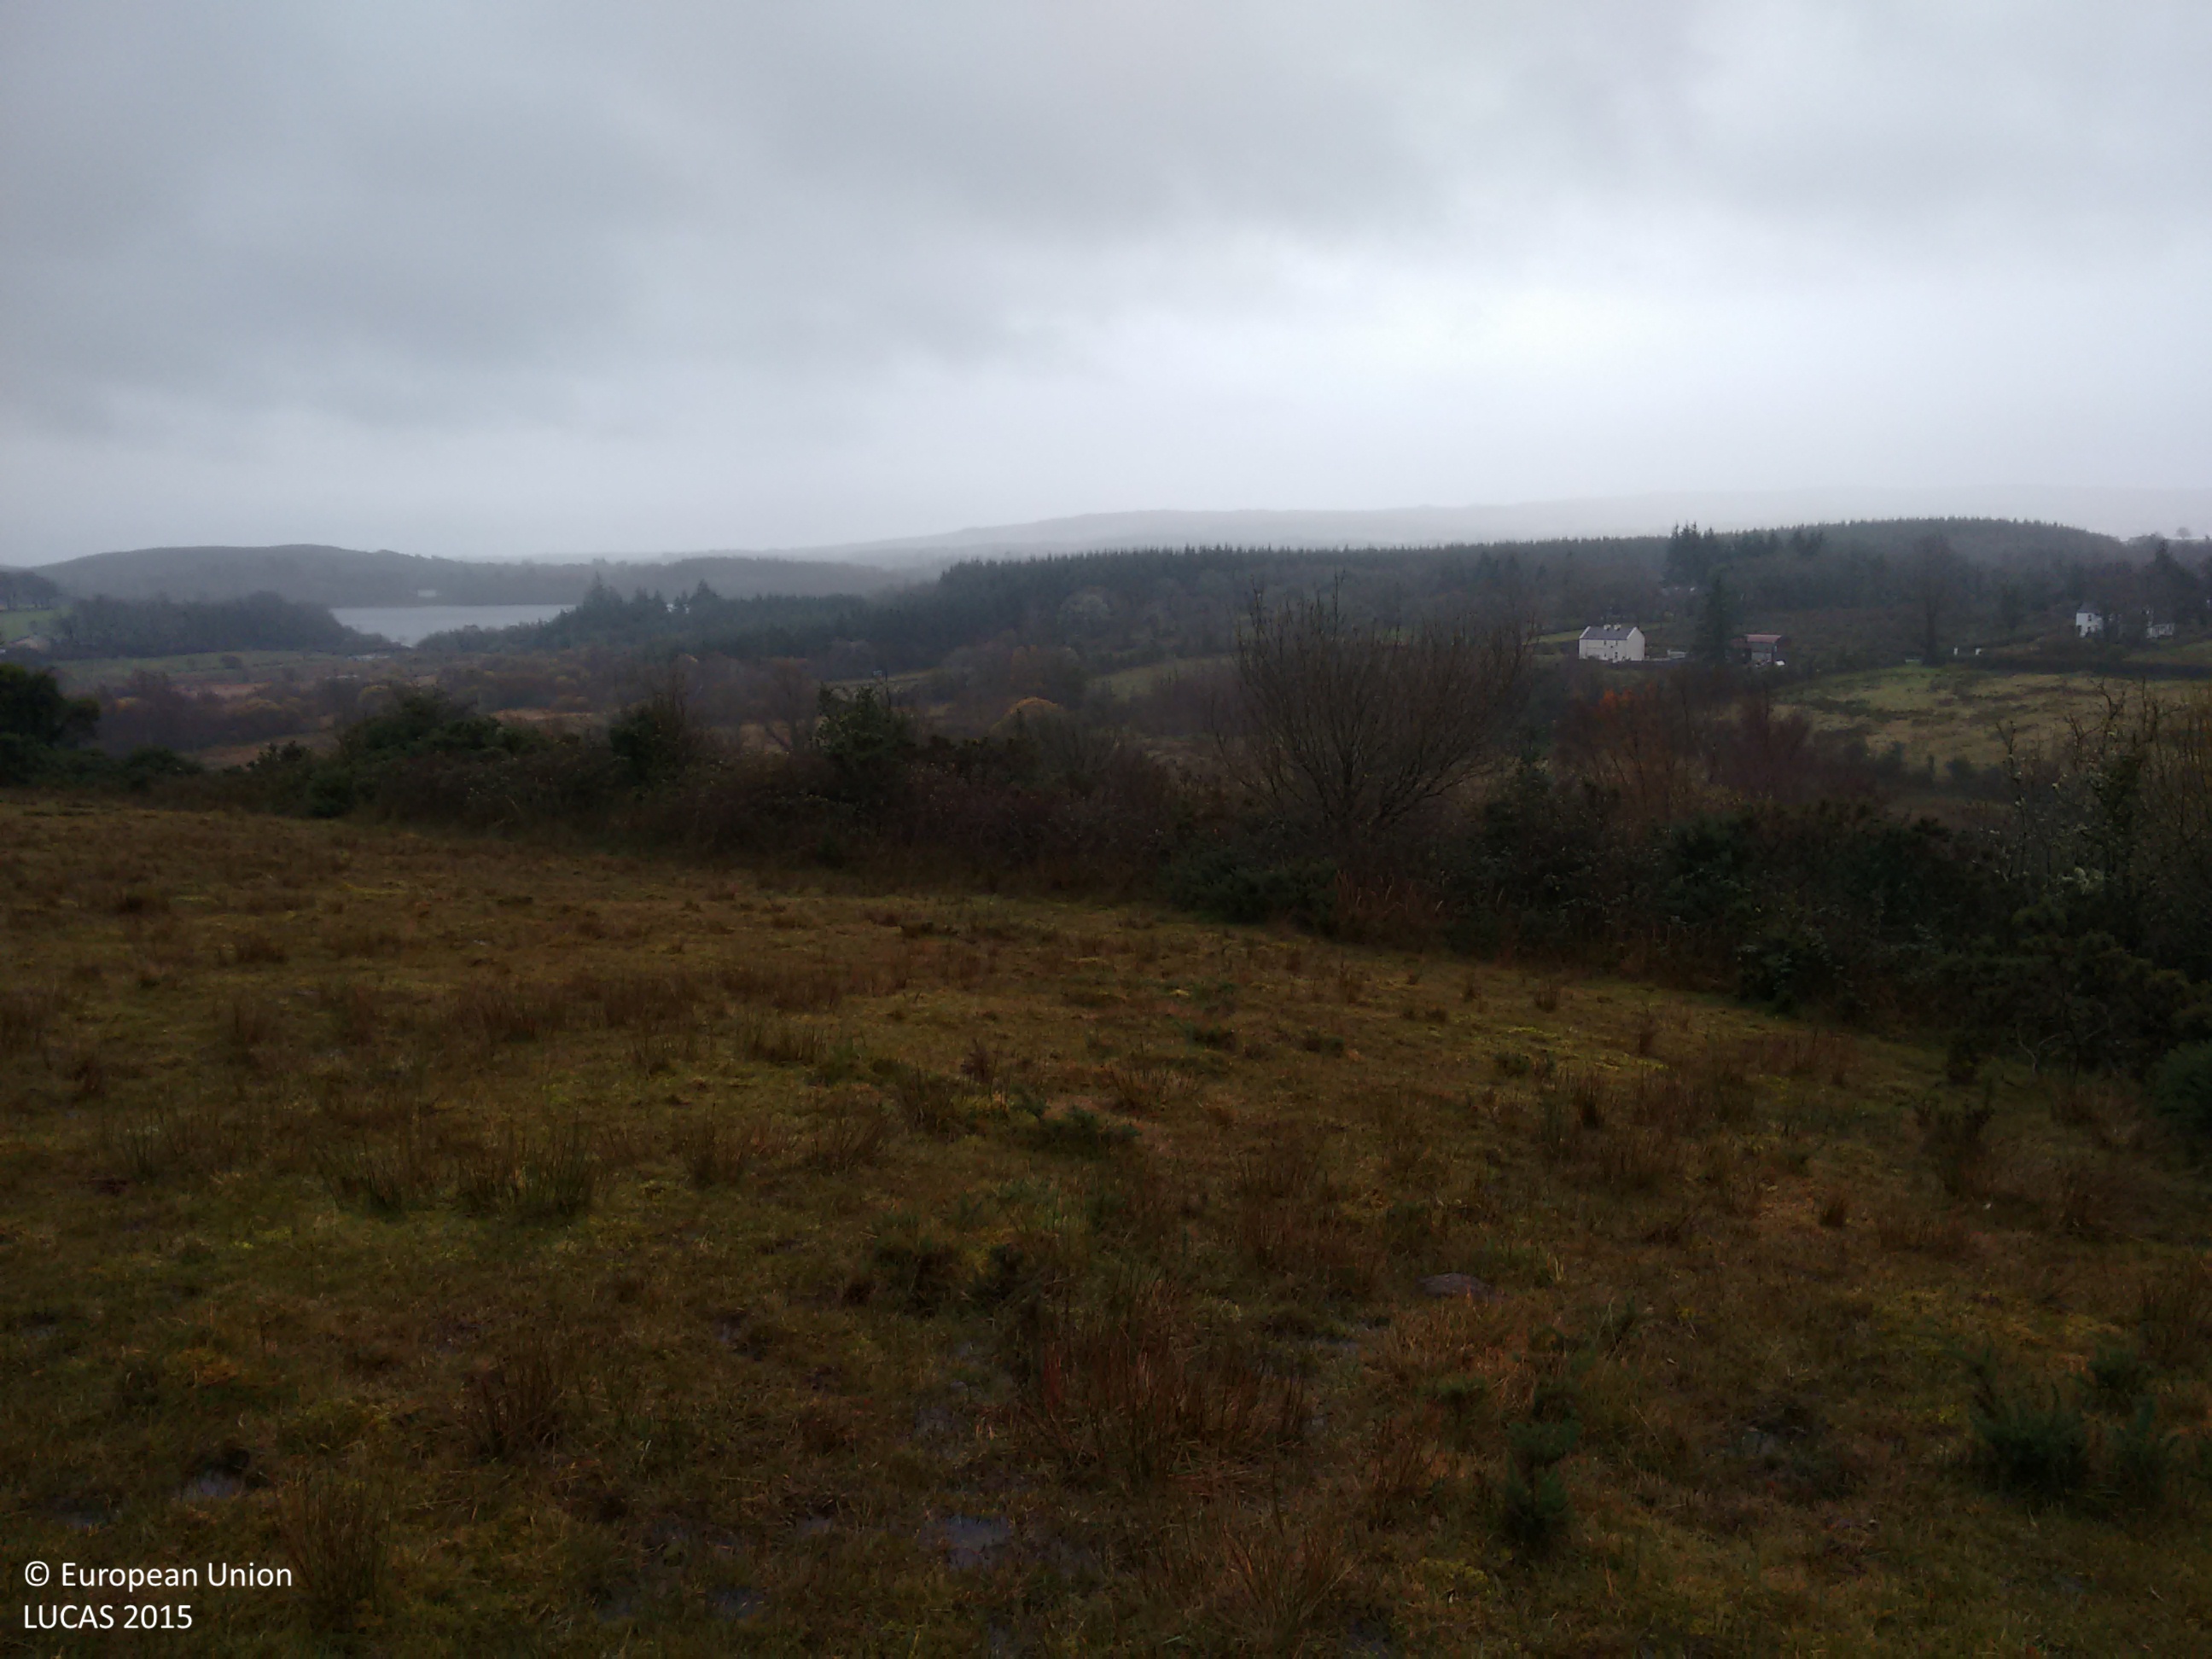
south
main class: Woodland
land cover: Broadleaved woodland
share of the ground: > 75 %
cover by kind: broadleaved forest trees 80 %, shrubs 10 %, herbaceous plants 10 %
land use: Semi-natural and natural areas not in use
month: November
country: IE
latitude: 54.0603
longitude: -8.2886
